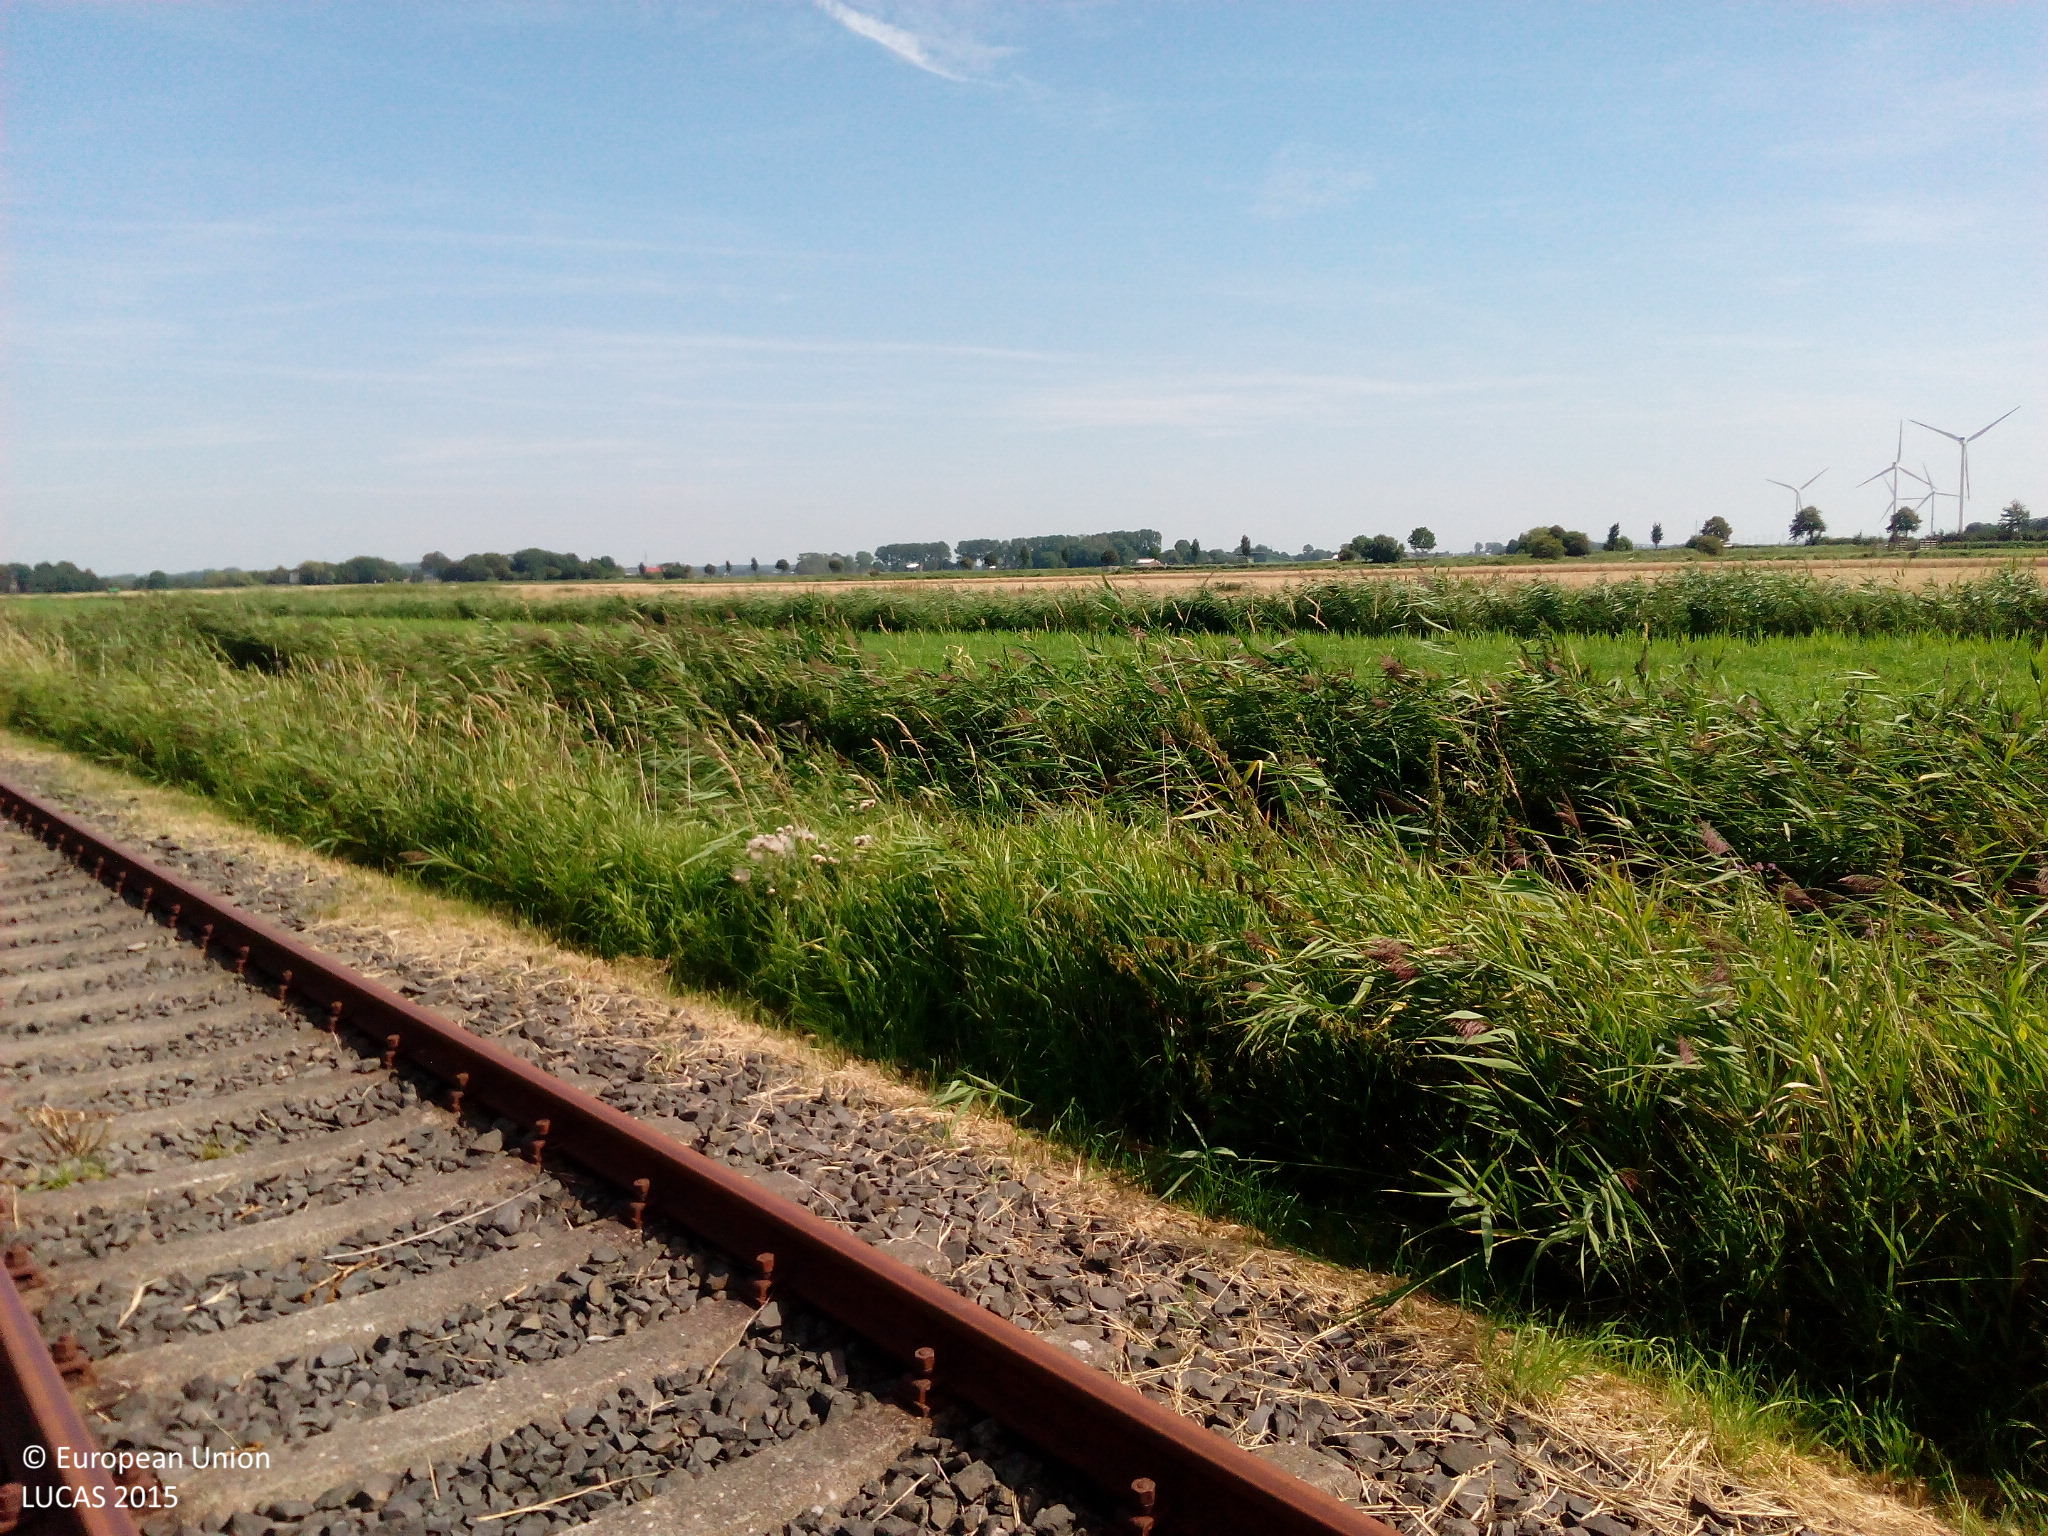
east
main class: Artificial land
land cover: Other artificial areas
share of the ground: < 10 %
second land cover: Maize
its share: > 75 %
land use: Electricity, gas and thermal power distribution
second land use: Agriculture (excluding fallow land and kitchen gardens)
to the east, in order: Artificial constructions in urban areas; Maize; Electric lines; Maize; Ditches and canals; Common wheat; Ditches and canals; Railways; Ditches and canals; Grassland without tree/shrub cover
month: August
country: DE
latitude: 53.9735
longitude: 9.0705
